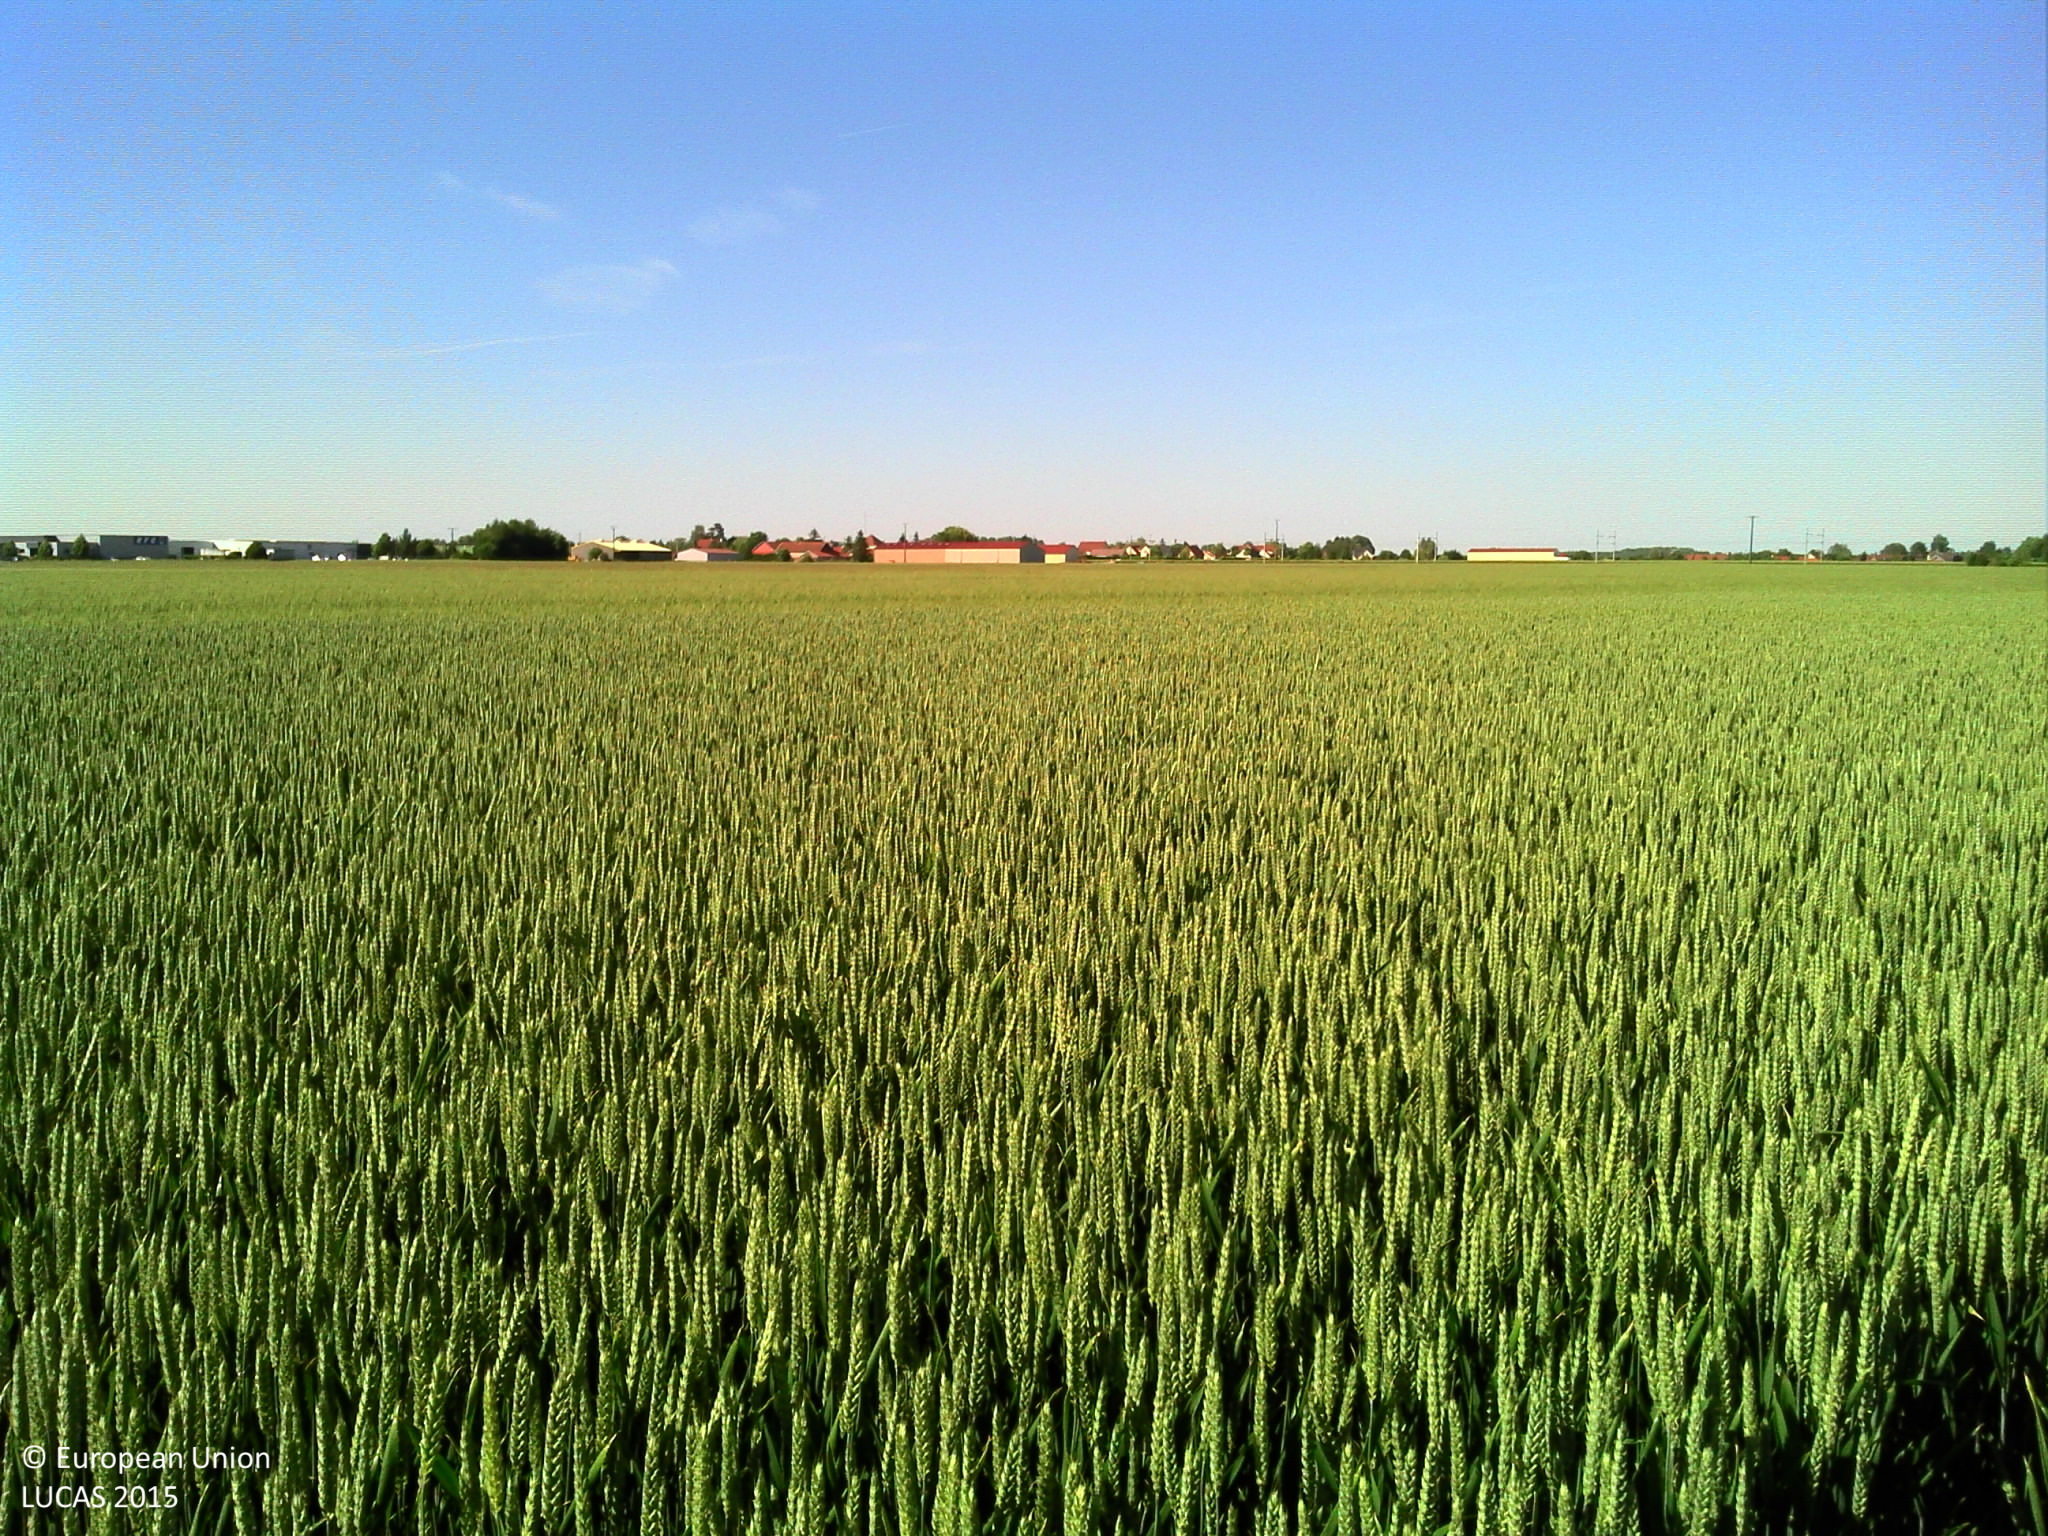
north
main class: Cropland
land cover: Common wheat
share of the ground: > 75 %
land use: Agriculture (excluding fallow land and kitchen gardens)
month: June
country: FR
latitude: 47.2479
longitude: 5.0725
